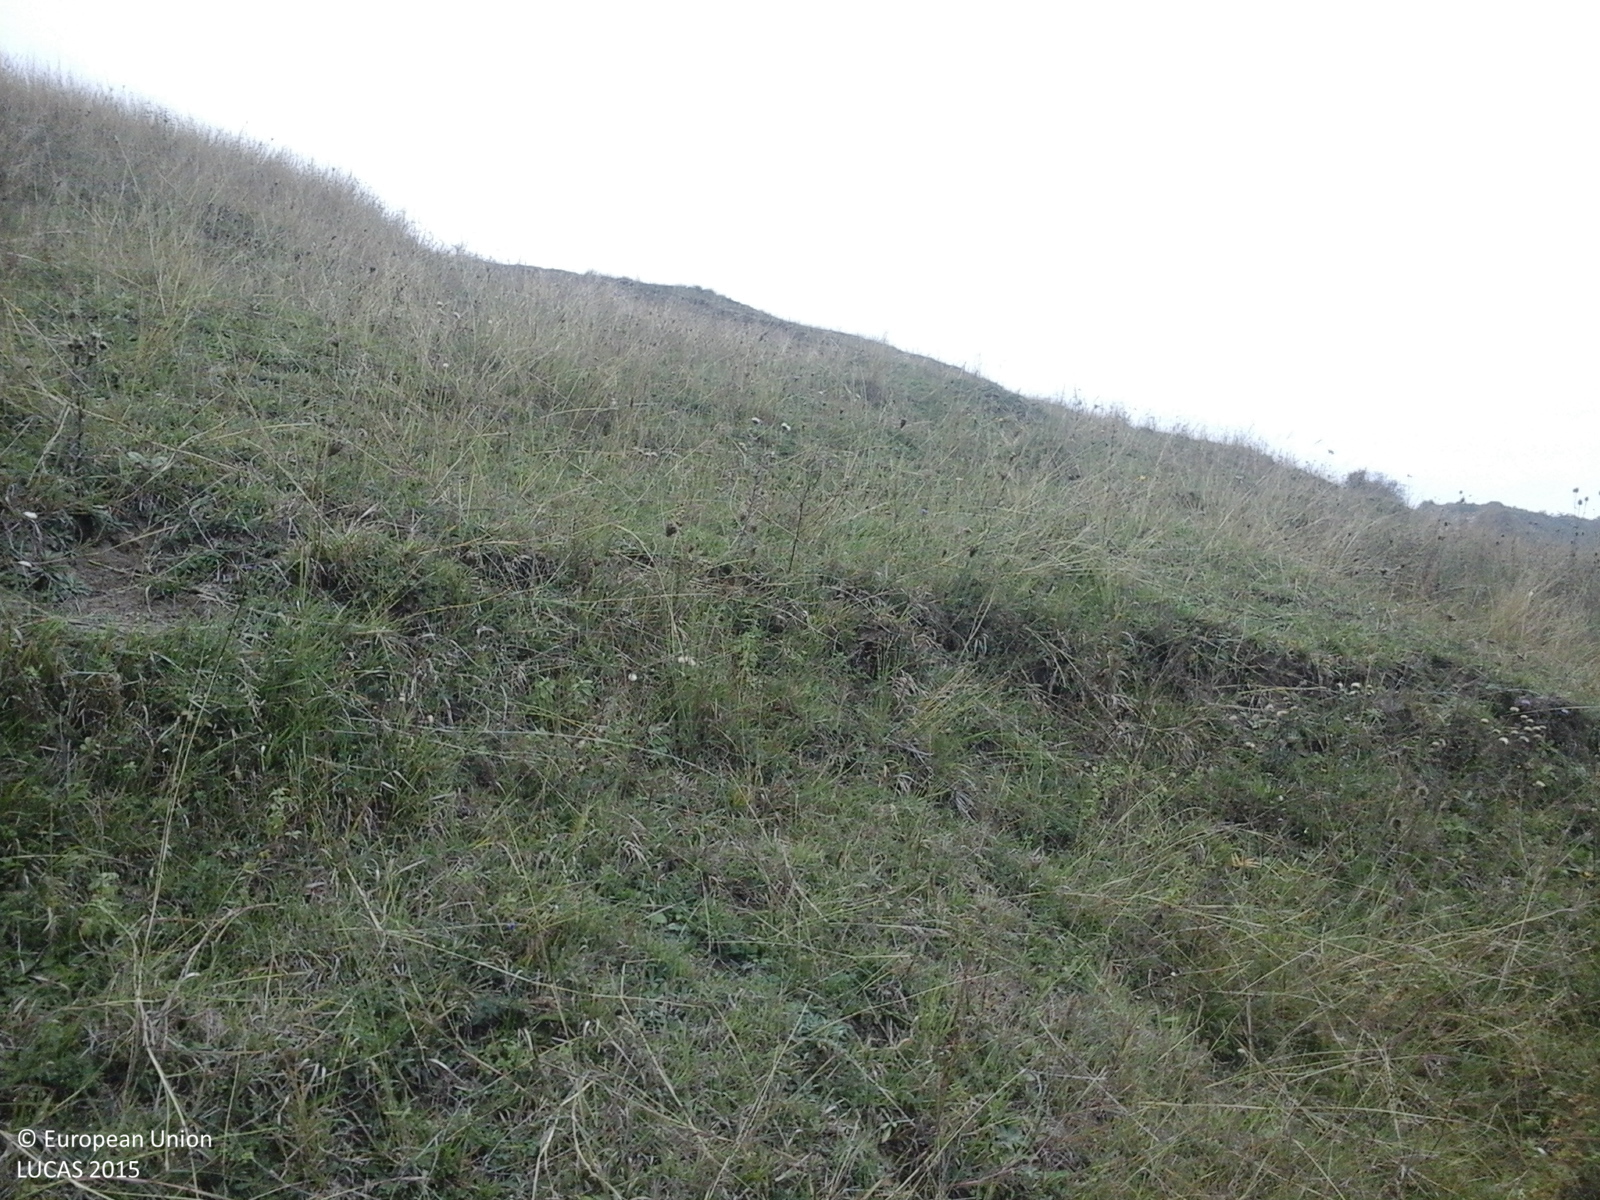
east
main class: Grassland
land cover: Grassland without tree/shrub cover
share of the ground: > 75 %
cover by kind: herbaceous plants 100 %
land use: Agriculture (excluding fallow land and kitchen gardens)
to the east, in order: Grassland without tree/shrub cover; Grassland with sparse tree/shrub cover
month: October
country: RO
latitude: 46.0453
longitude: 24.8092
